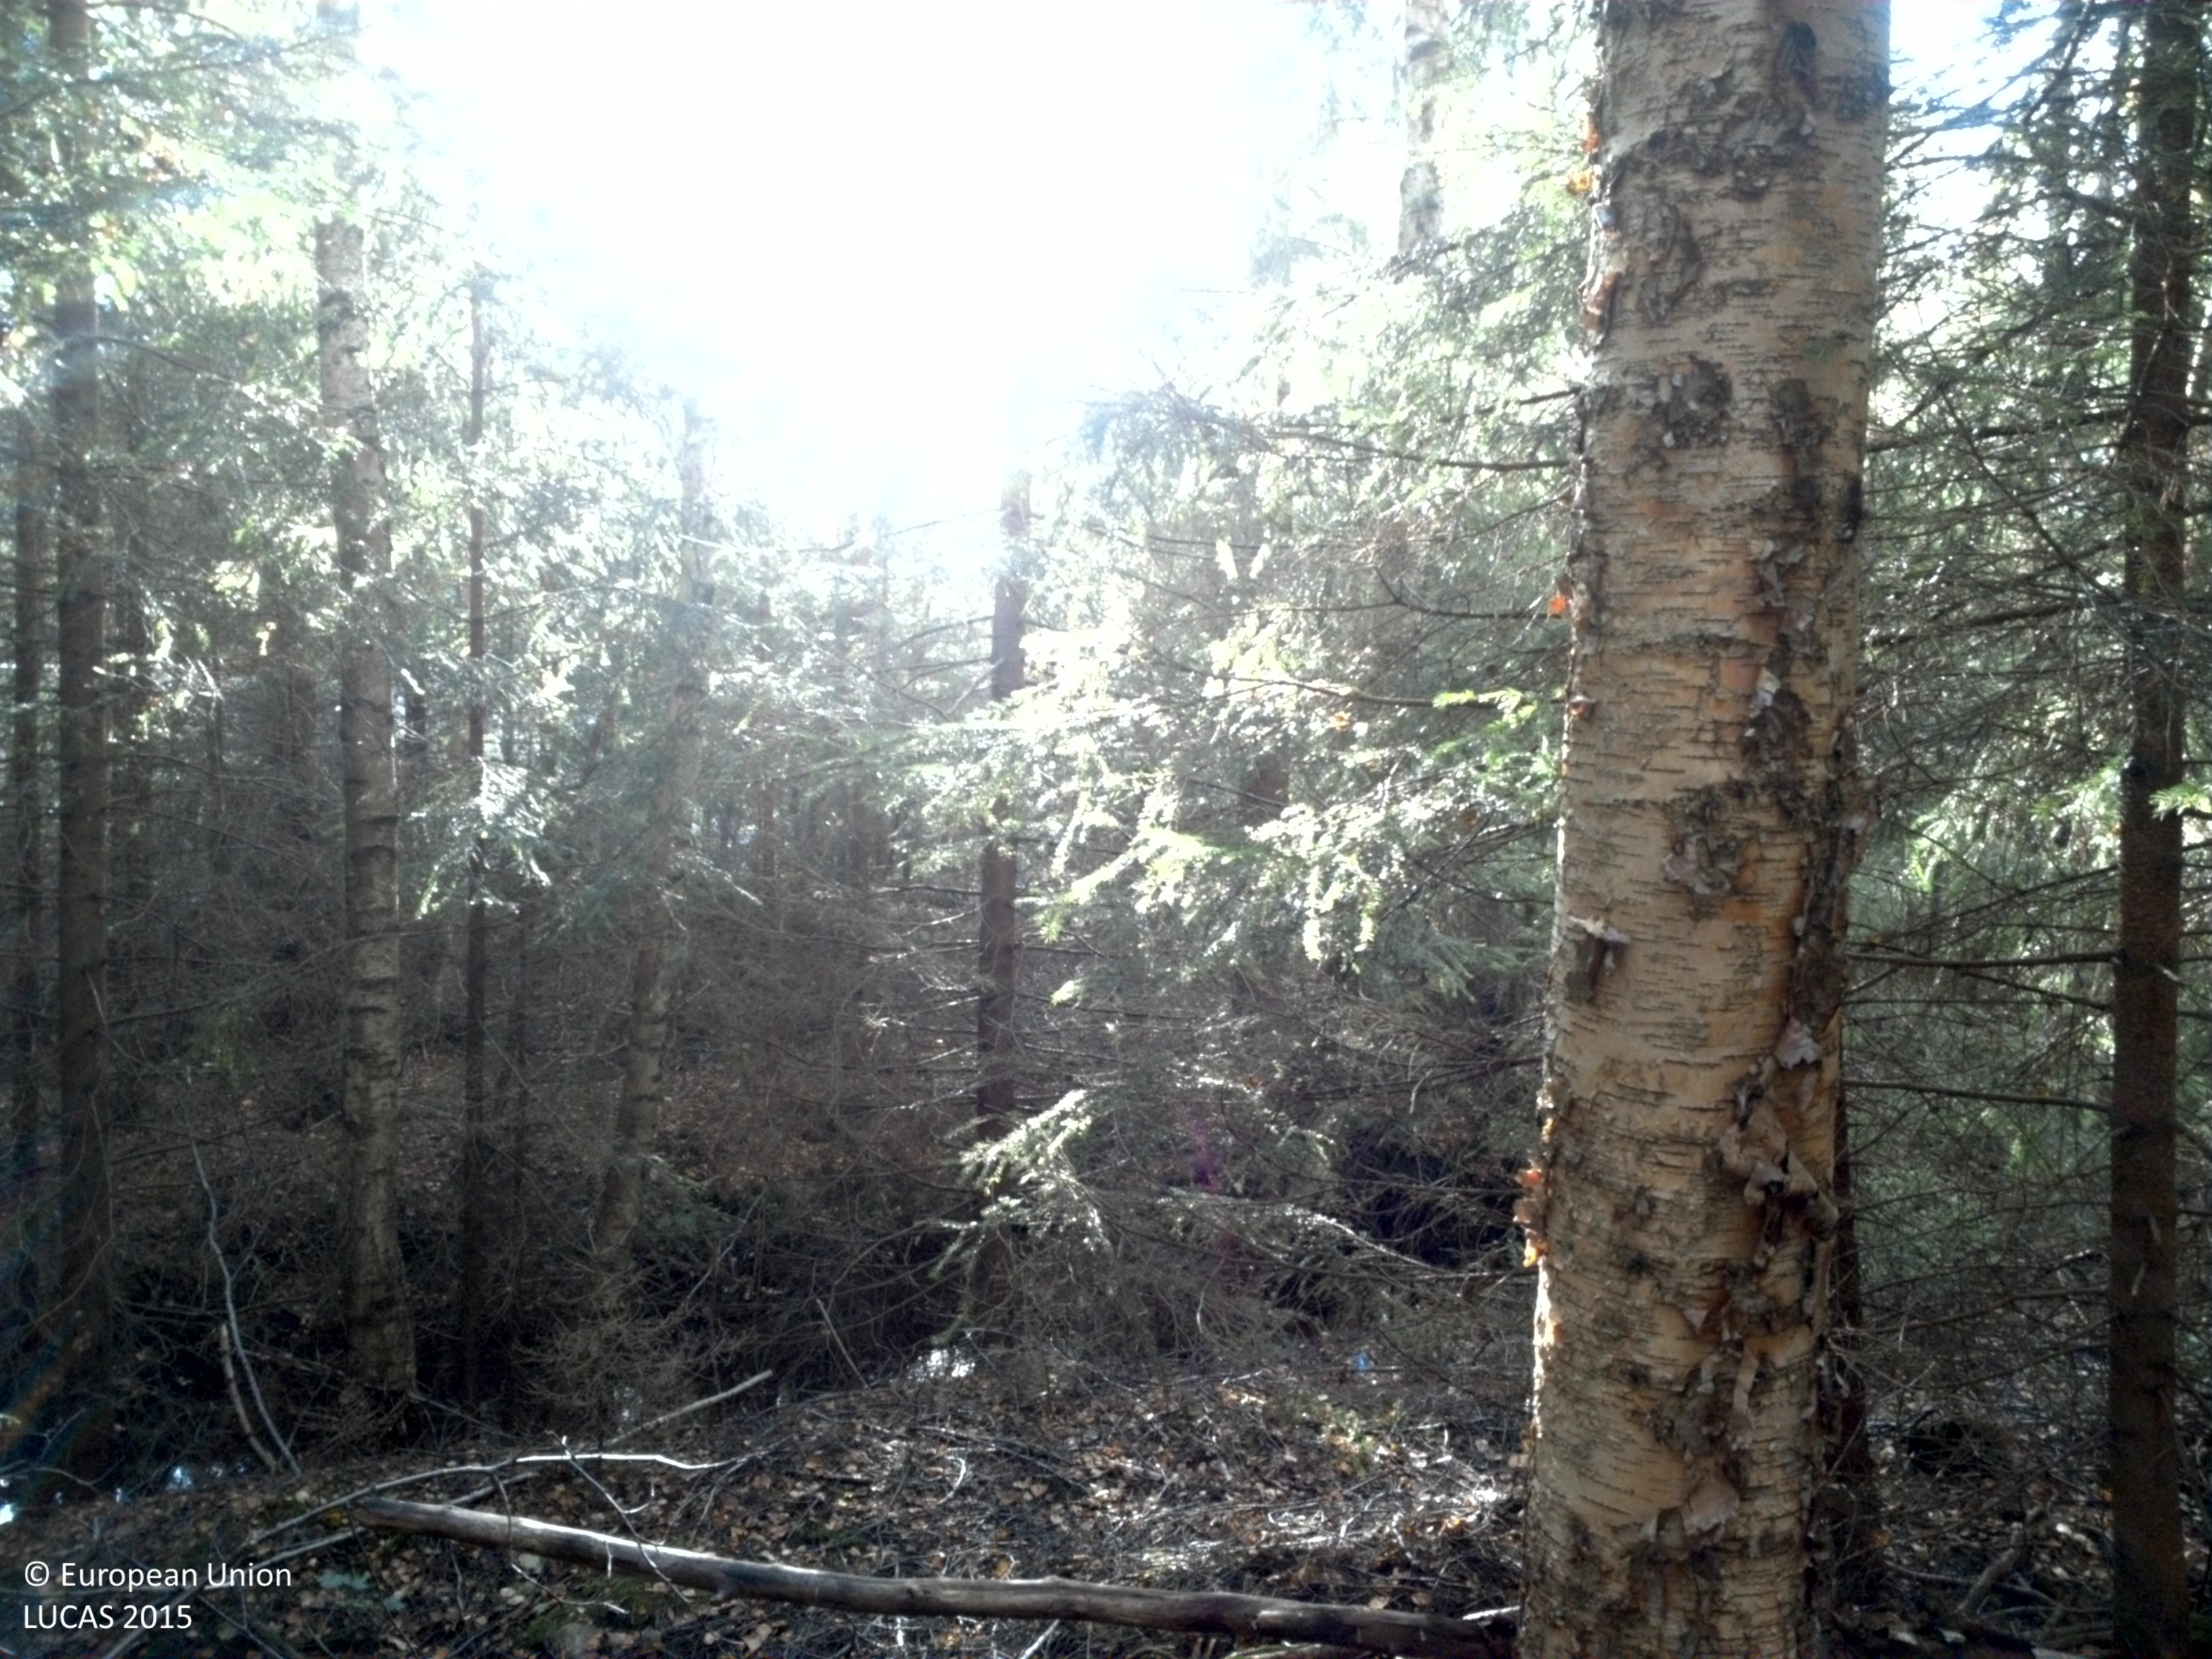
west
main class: Woodland
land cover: Spruce dominated mixed woodland
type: boreal forest
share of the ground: > 75 %
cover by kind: coniferous forest trees 65 %, broadleaved forest trees 25 %, lichens and mosses 5 %, unconsolidated bare surface 5 %
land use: Forestry
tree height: > 5 m
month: September
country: SE
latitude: 57.8618
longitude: 13.0122
